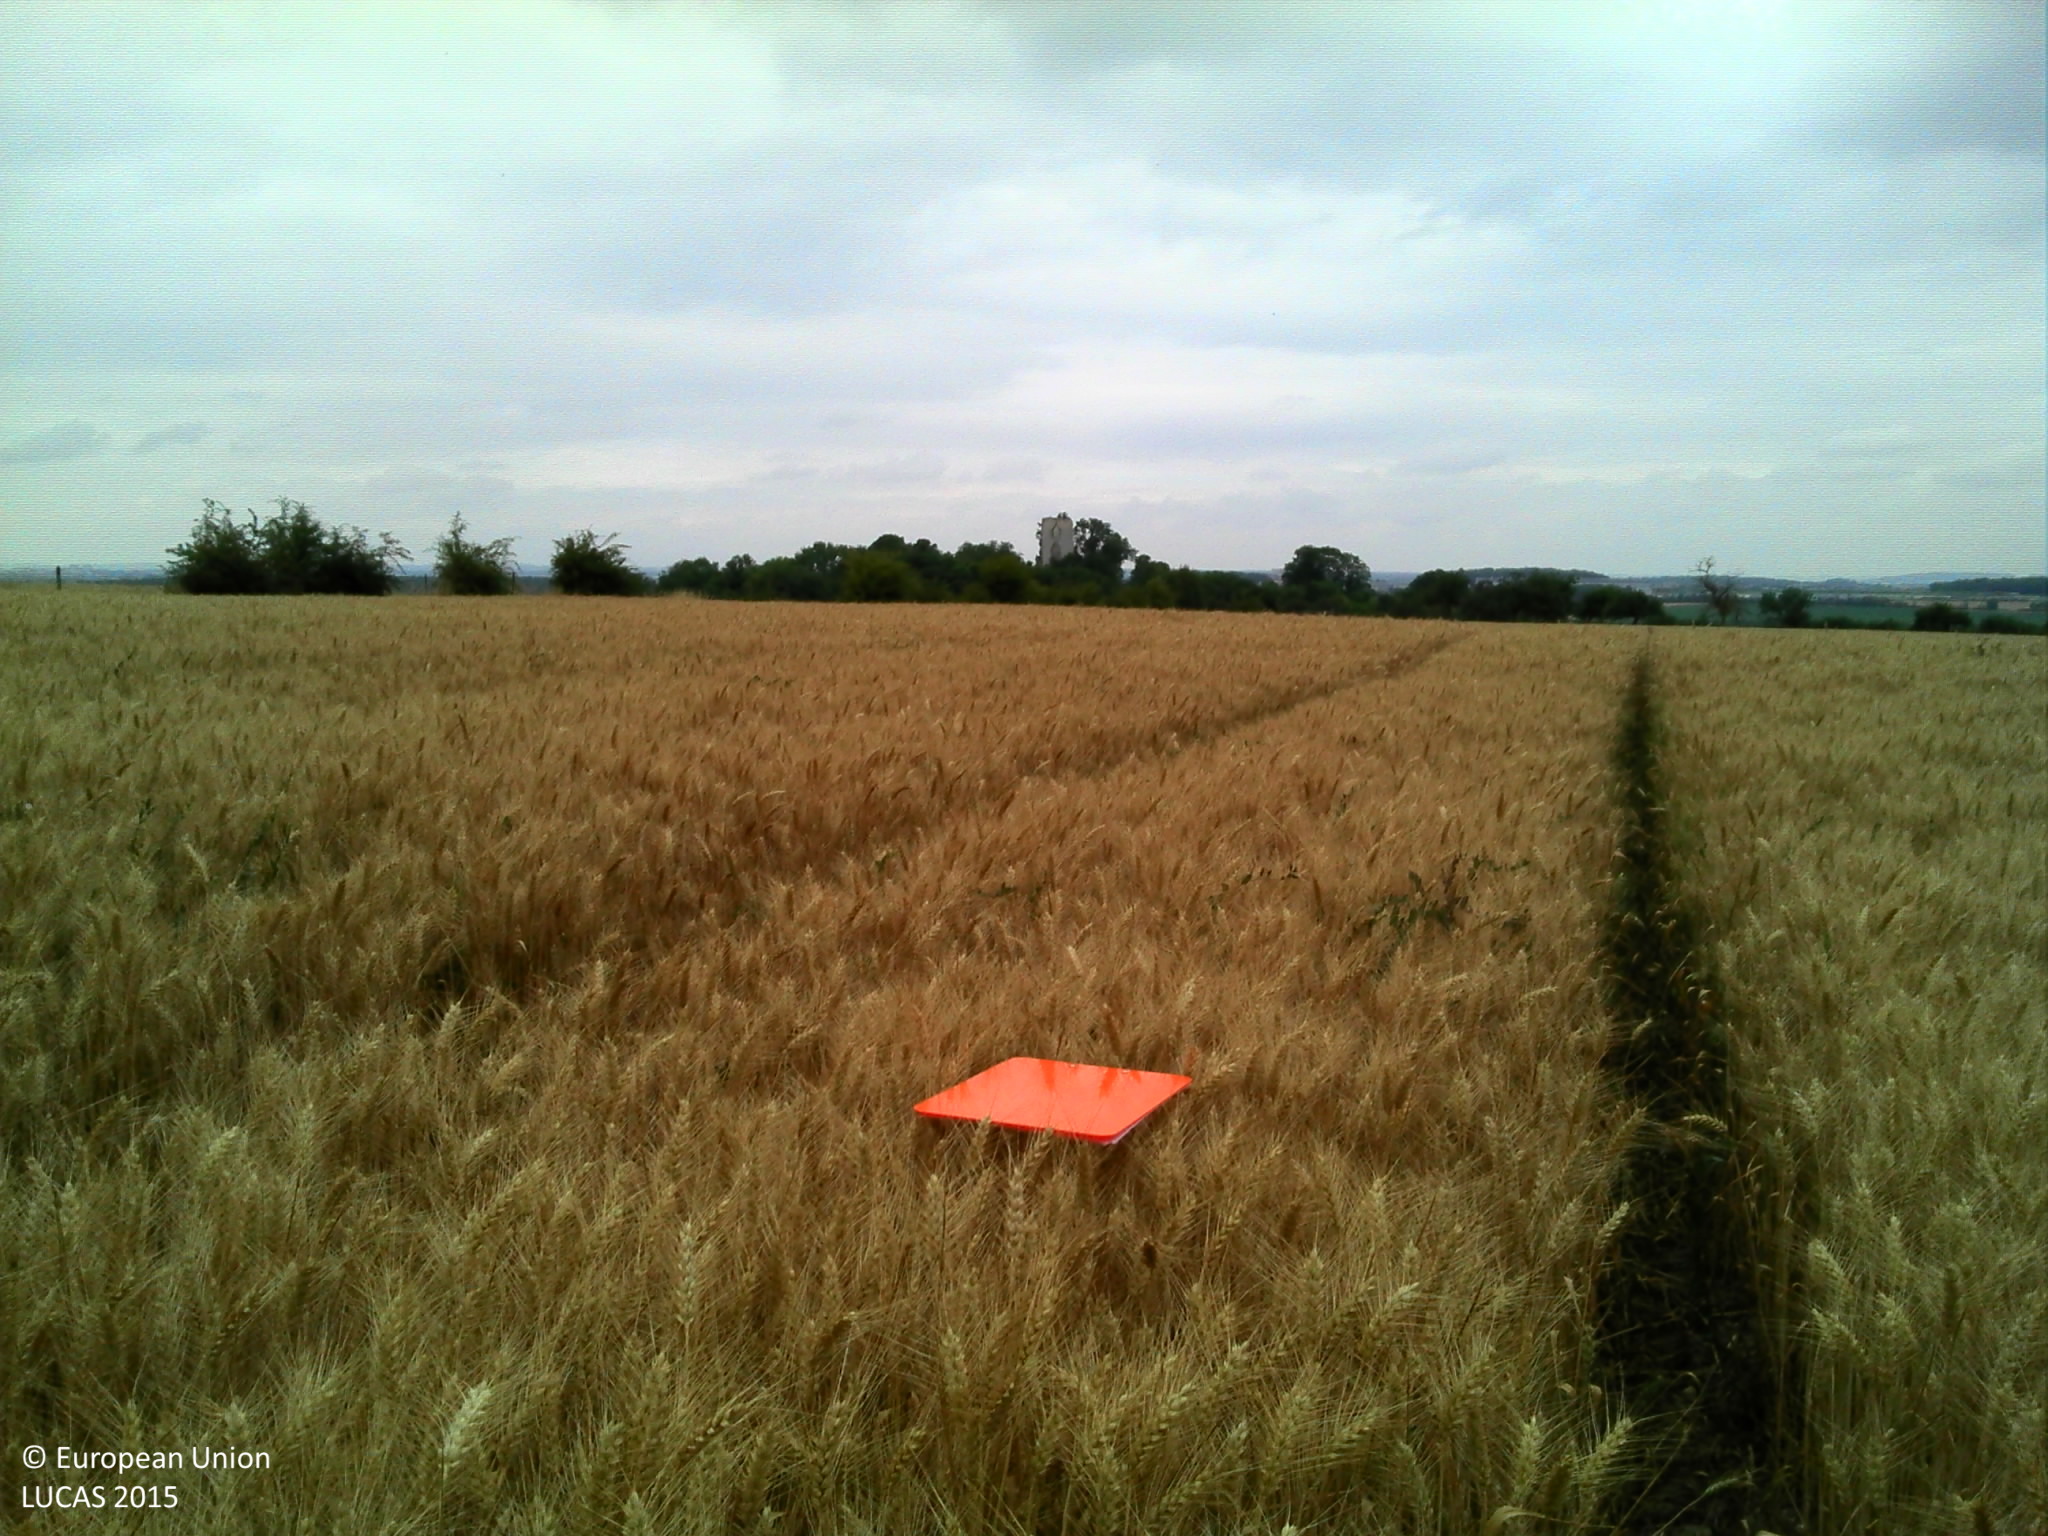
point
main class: Cropland
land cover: Common wheat
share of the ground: > 75 %
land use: Agriculture (excluding fallow land and kitchen gardens)
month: July
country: FR
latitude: 49.8388
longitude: 2.3812
